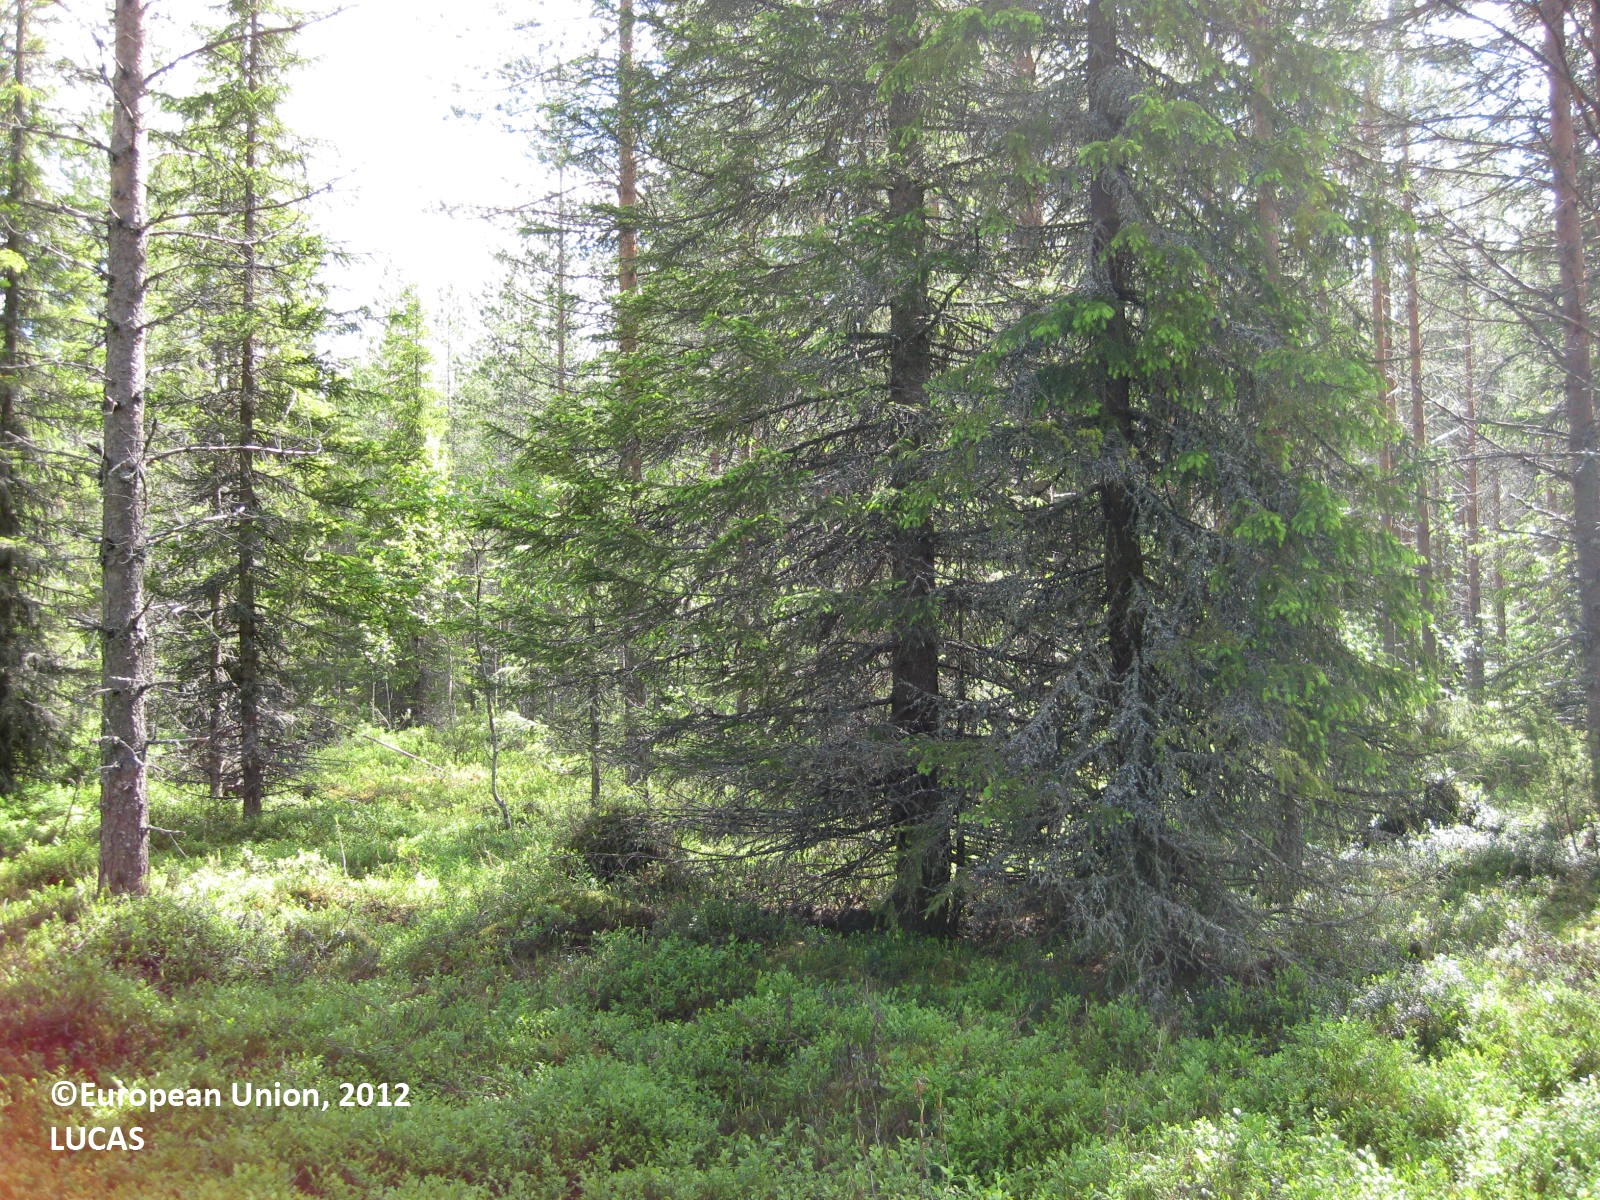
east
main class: Woodland
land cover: Other coniferous woodland
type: boreal forest
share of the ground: 50 - 75 %
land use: Forestry
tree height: > 5 m
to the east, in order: Other coniferous woodland; Pine dominated coniferous woodland; Ditches and canals; Pine dominated coniferous woodland; Ditches and canals; Pine dominated coniferous woodland; Spruce dominated coniferous woodland; Pine dominated coniferous woodland
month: June
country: FI
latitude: 65.3743
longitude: 28.2874
